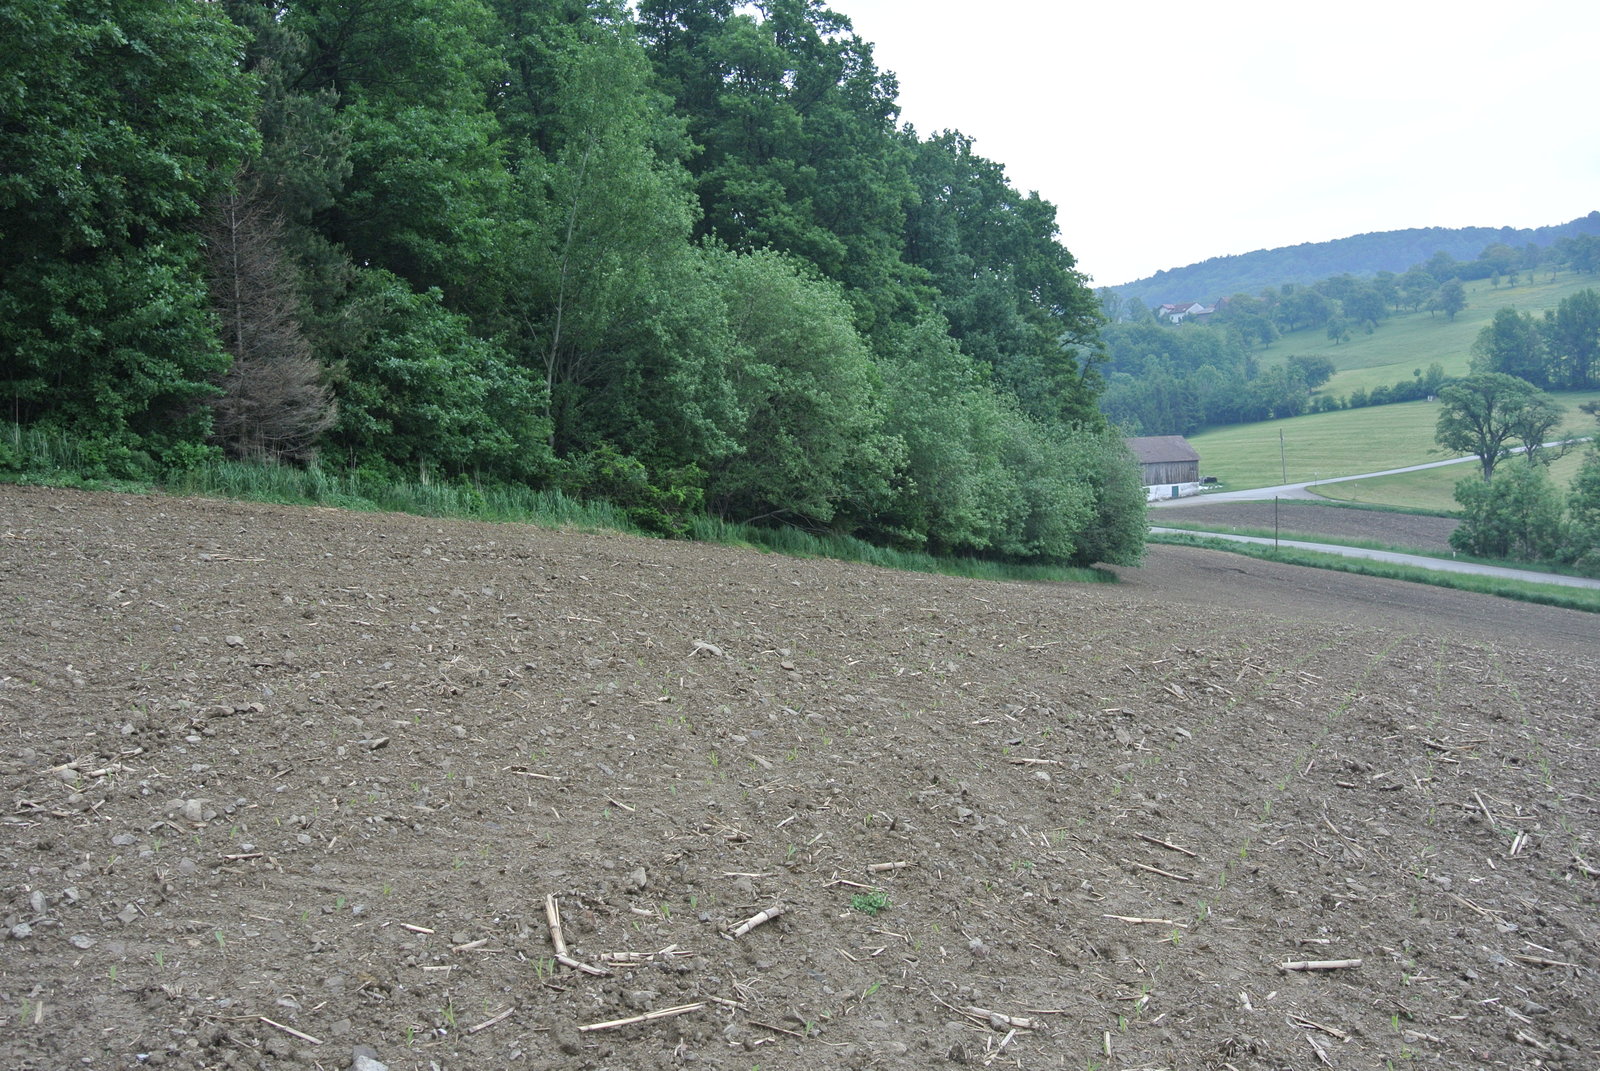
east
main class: Cropland
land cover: Maize
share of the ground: < 10 %
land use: Agriculture (excluding fallow land and kitchen gardens)
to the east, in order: Maize; Broadleaved woodland; Grass margins; Paved roads, cycling and walking lanes; Grassland without tree/shrub cover; Electric lines; Grassland without tree/shrub cover; Apple fruit; Grassland without tree/shrub cover
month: May
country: AT
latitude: 48.1046
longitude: 15.8450
